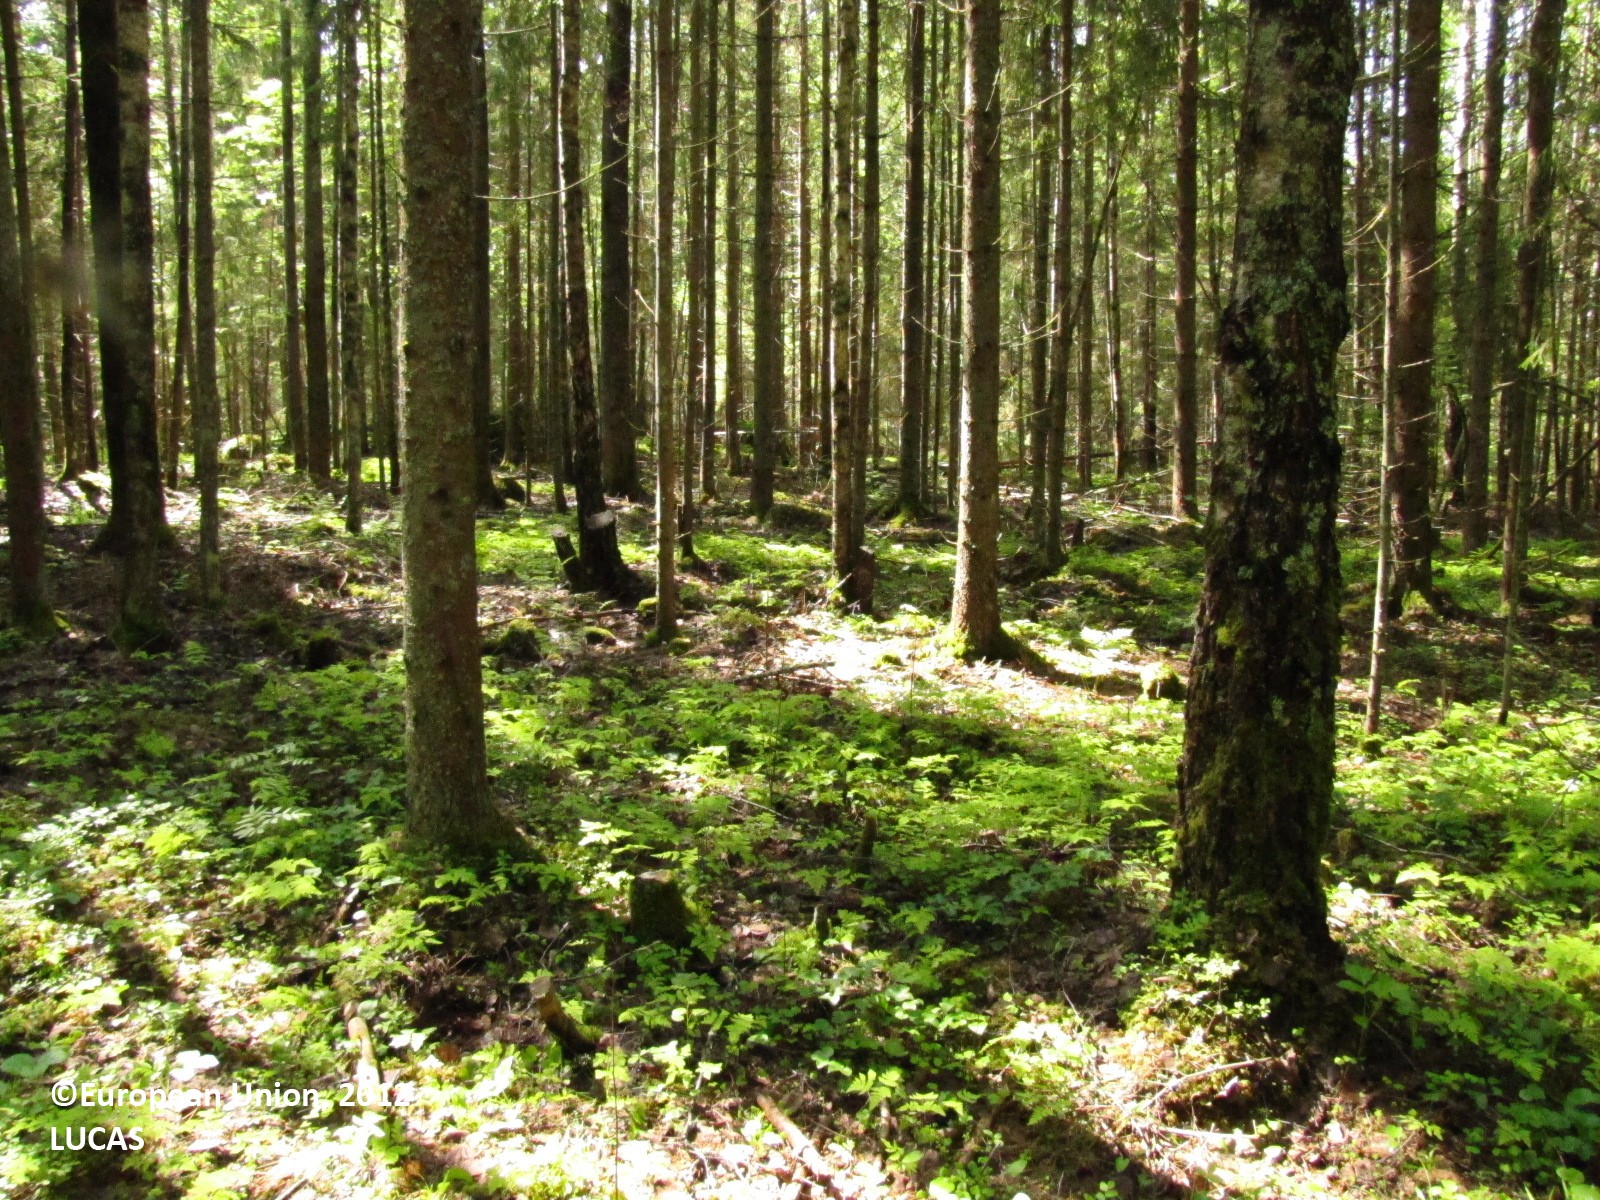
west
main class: Woodland
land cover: Spruce dominated mixed woodland
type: hemiboreal forest and nemoral coniferous forest and mixed broadleaved-coniferous forest
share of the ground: > 75 %
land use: Forestry
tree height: > 5 m
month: June
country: FI
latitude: 61.5802
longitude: 23.0869
